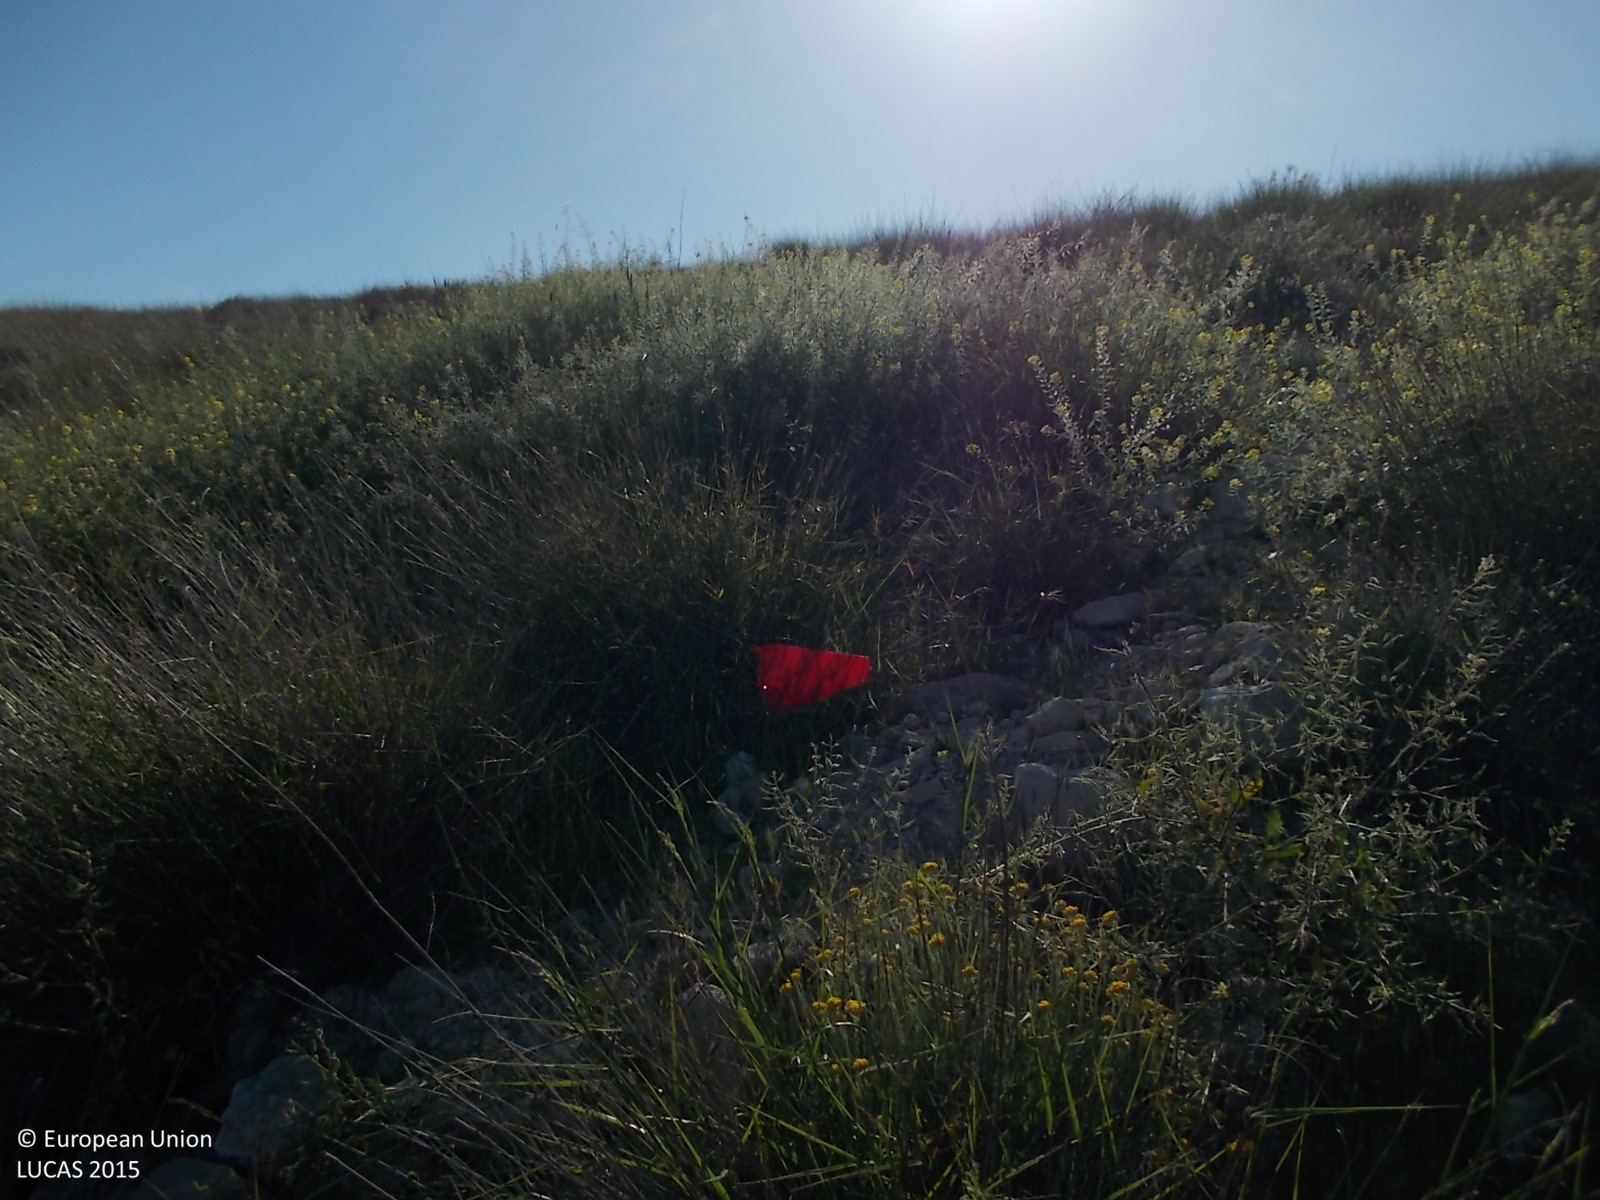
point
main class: Shrubland
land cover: Shrubland without tree cover
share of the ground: > 75 %
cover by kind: shrubs 100 %
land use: Semi-natural and natural areas not in use
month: April
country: CY
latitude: 34.9853
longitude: 33.4941
